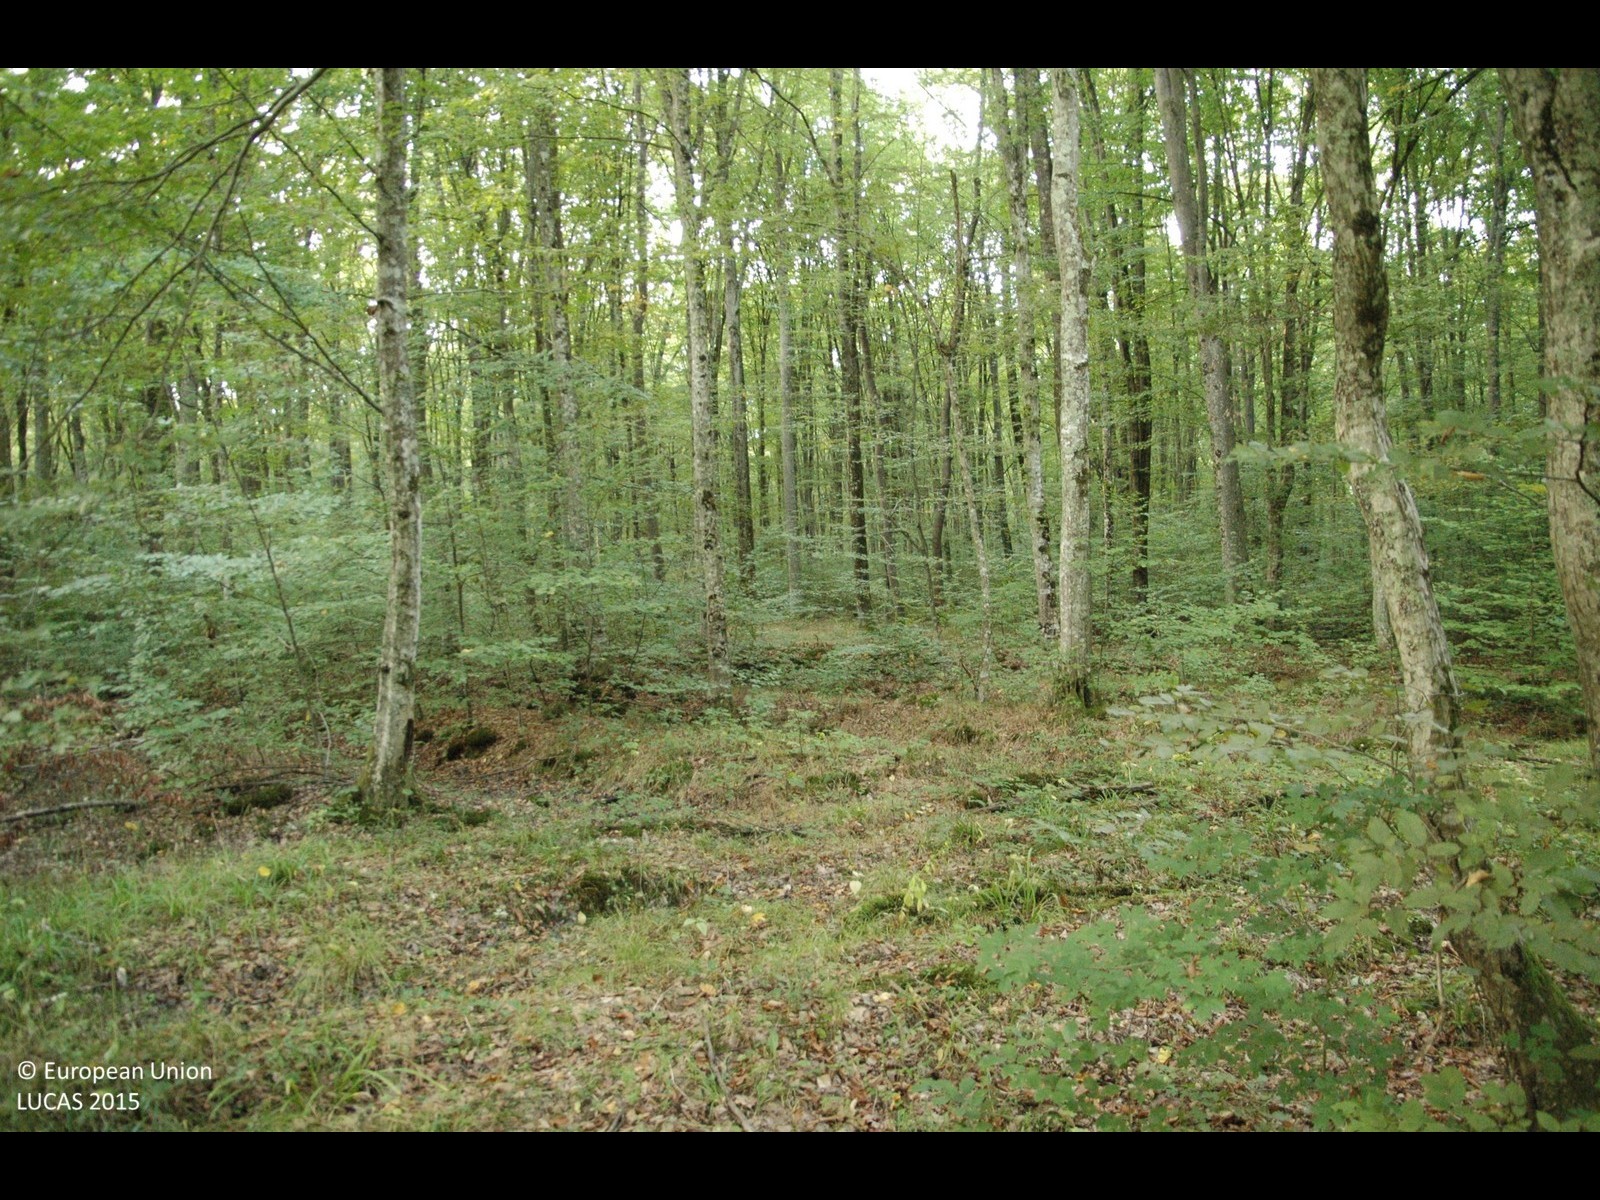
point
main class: Woodland
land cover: Broadleaved woodland
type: mesophytic deciduous forest
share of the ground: > 75 %
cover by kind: broadleaved forest trees 100 %
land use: Forestry
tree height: > 5 m
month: October
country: HR
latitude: 45.5385
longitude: 16.2087
